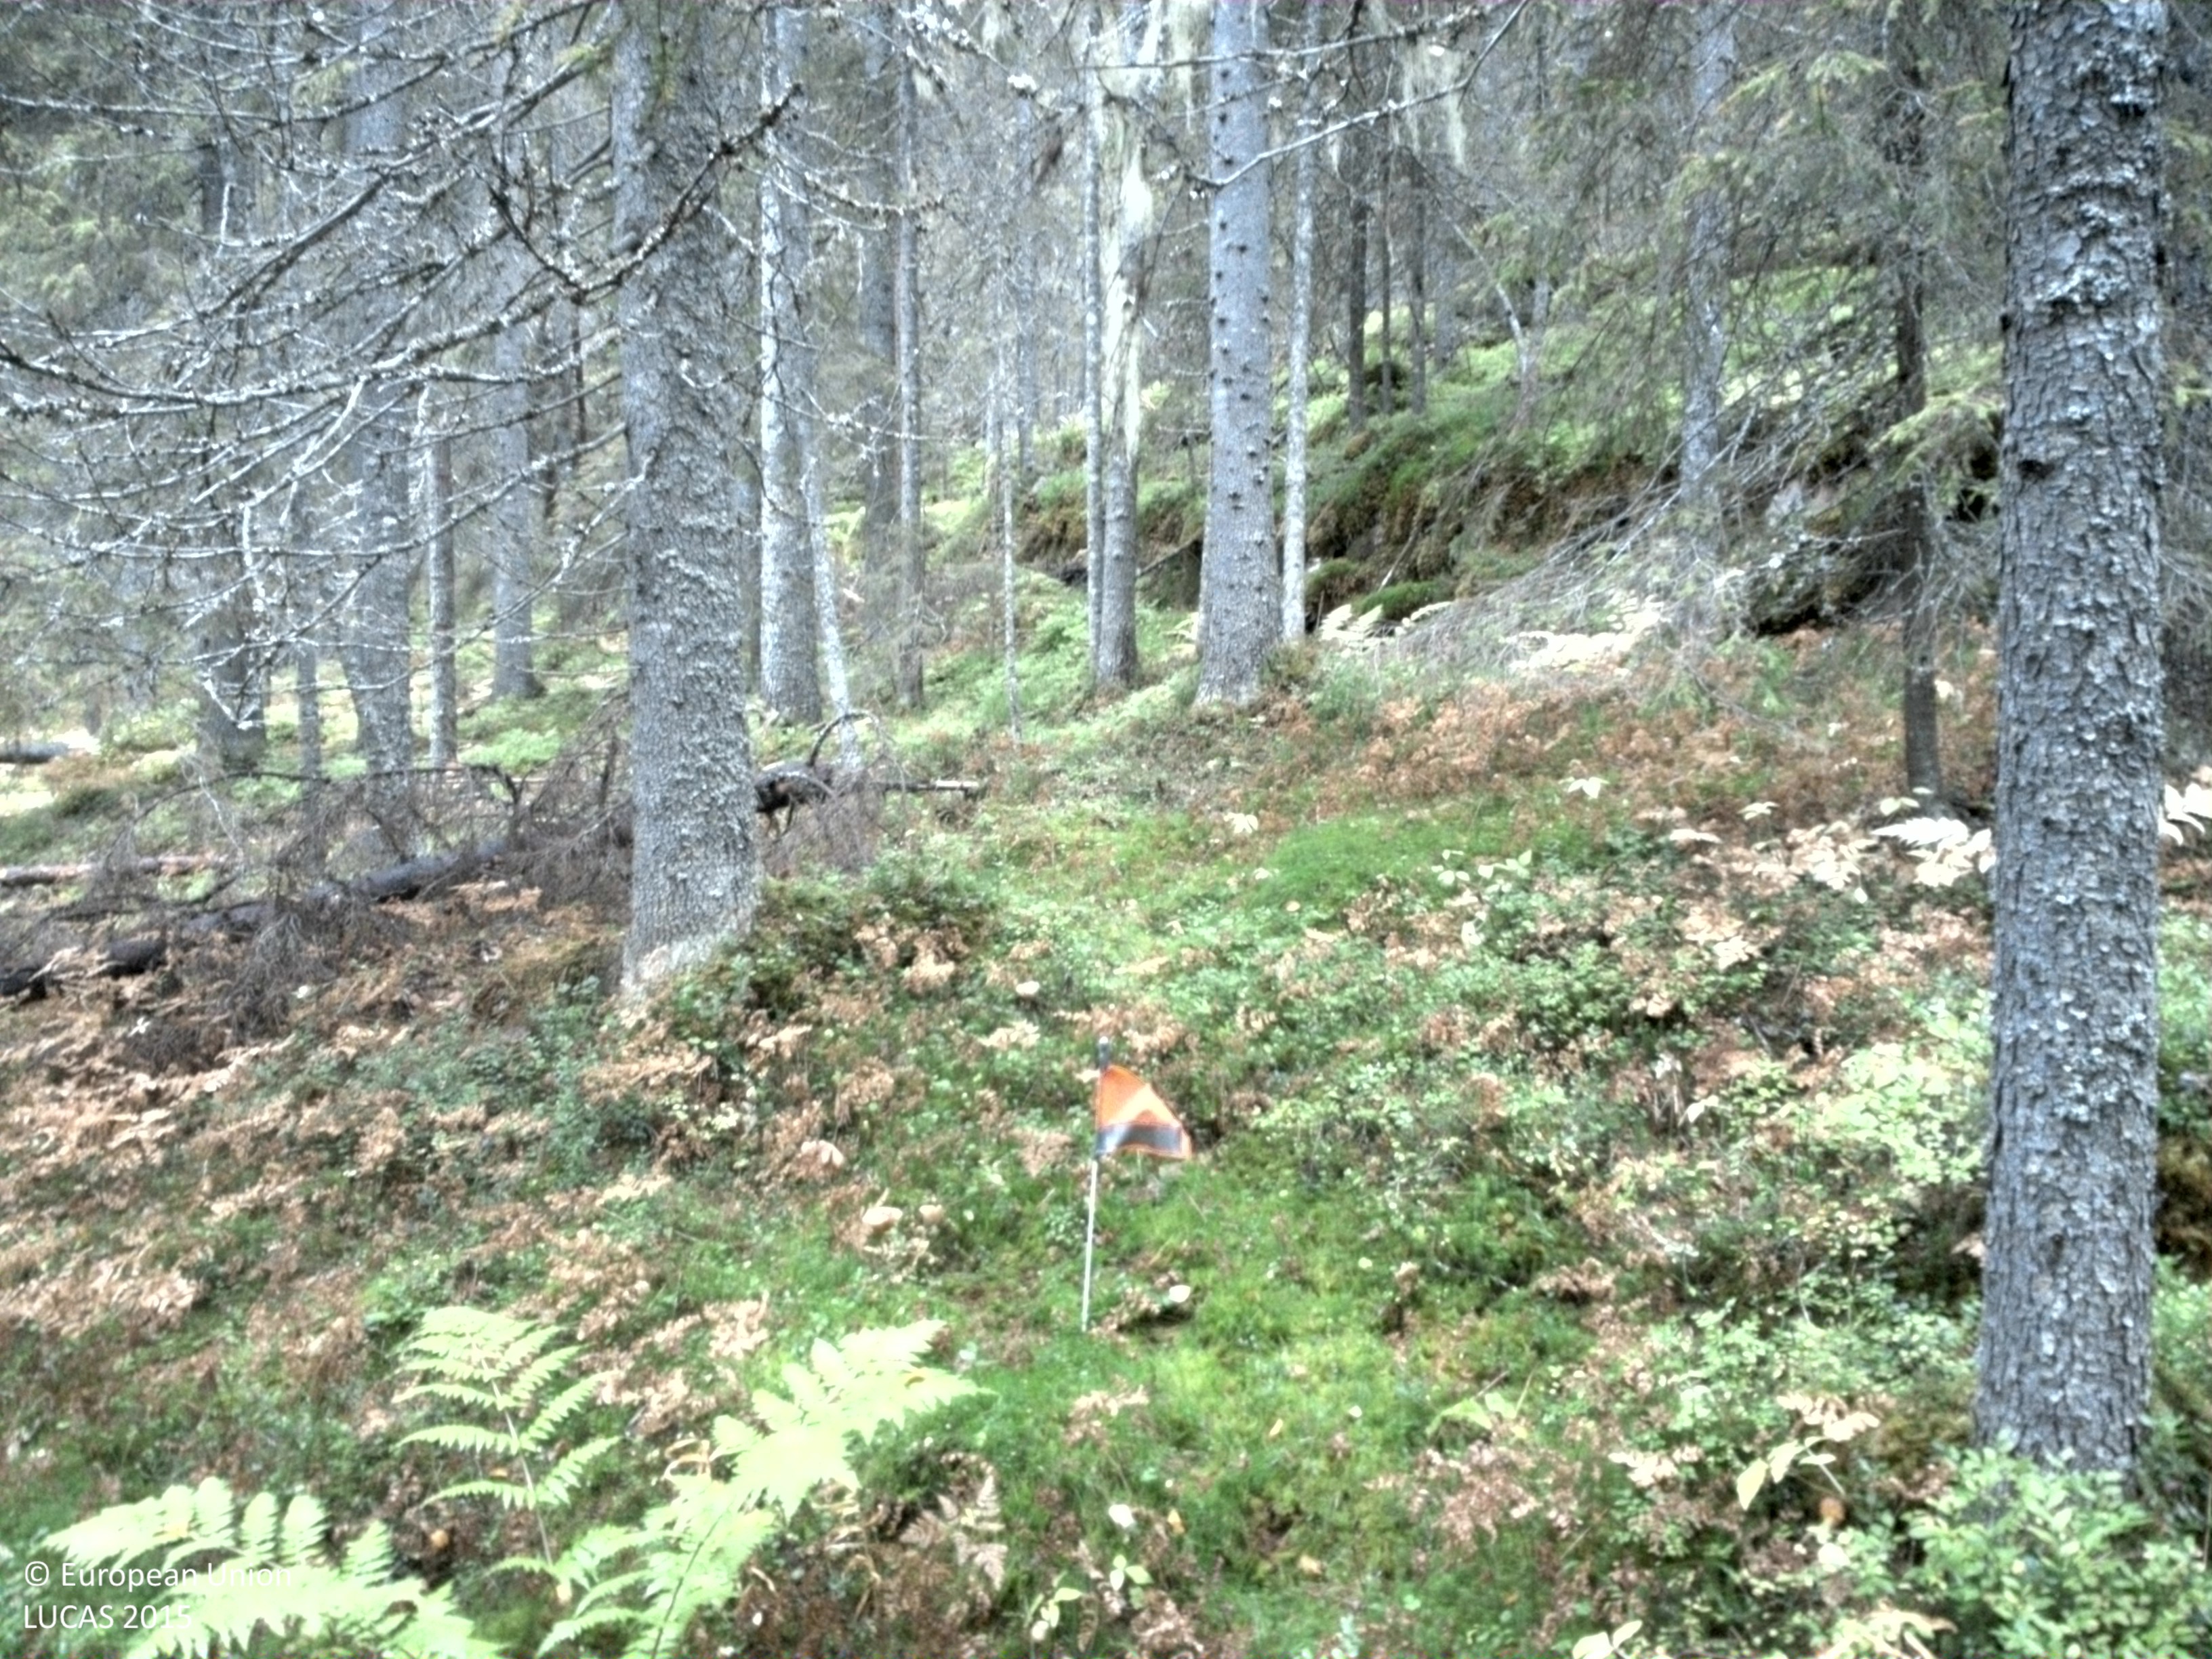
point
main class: Woodland
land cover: Spruce dominated coniferous woodland
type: boreal forest
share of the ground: 50 - 75 %
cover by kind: coniferous forest trees 60 %, shrubs 15 %, herbaceous plants 15 %, lichens and mosses 10 %
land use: Forestry
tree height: > 5 m
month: September
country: SE
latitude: 64.8784
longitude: 17.7966
